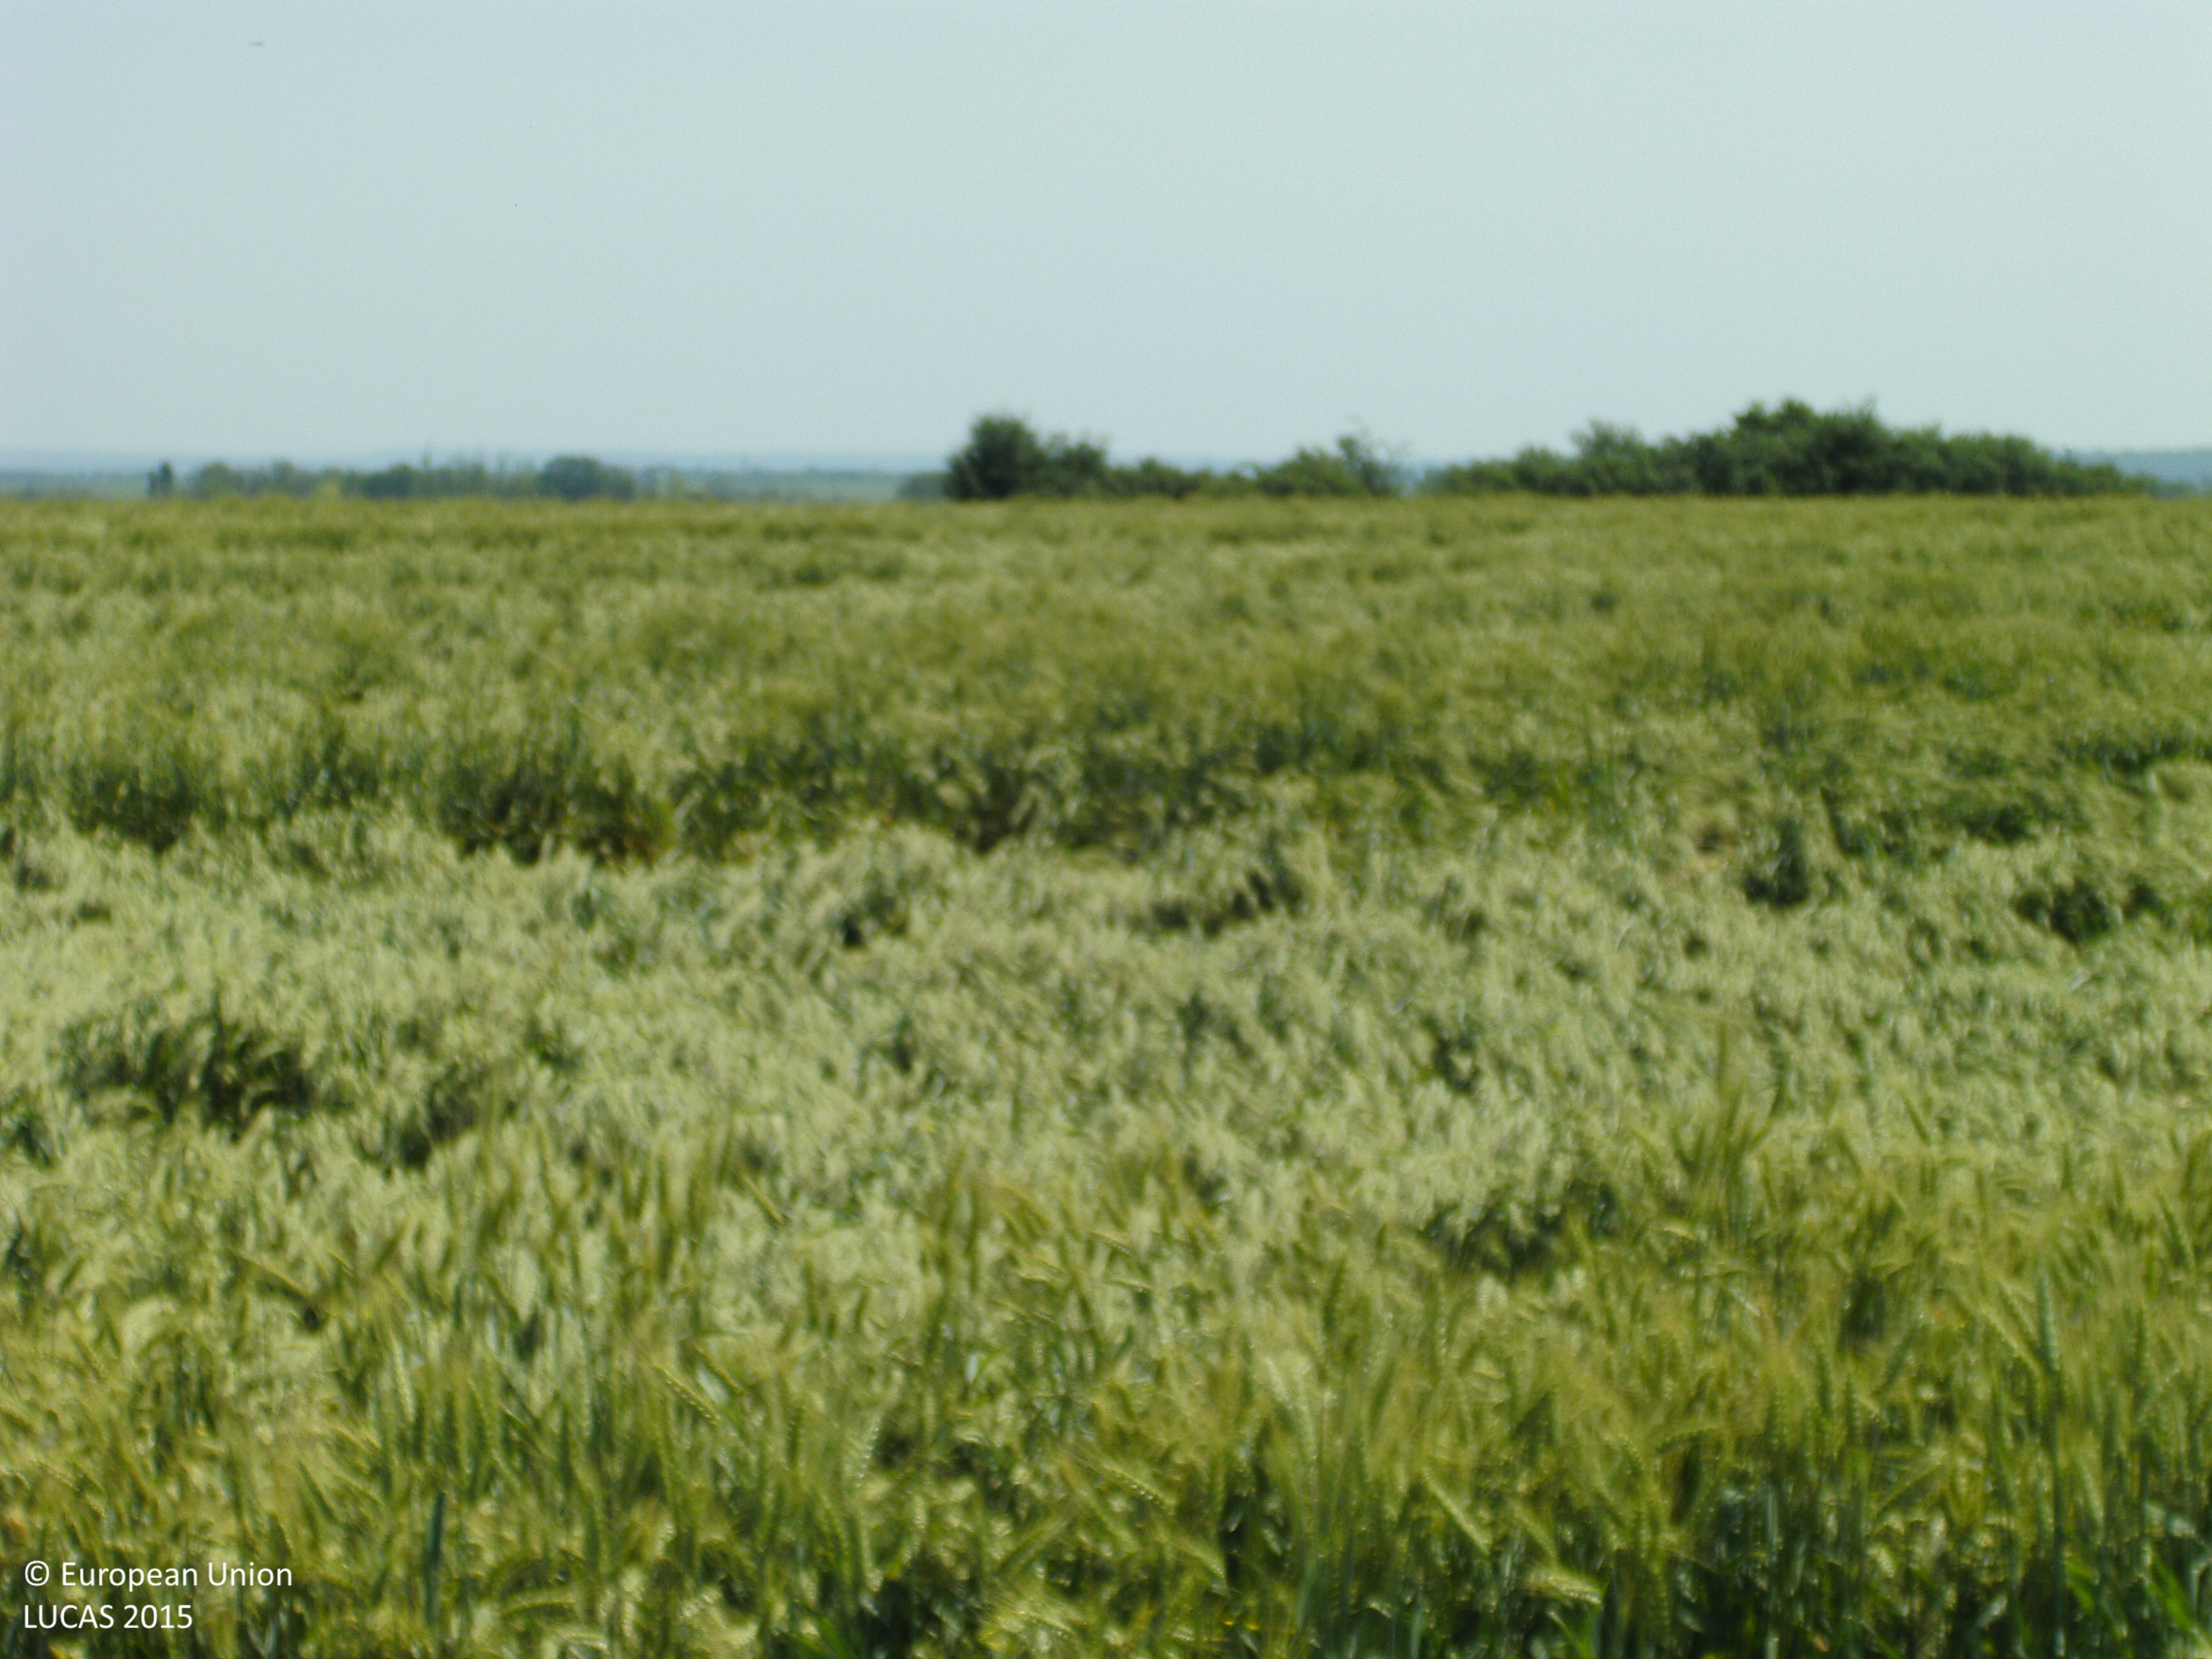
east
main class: Cropland
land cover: Common wheat
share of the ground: > 75 %
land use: Agriculture (excluding fallow land and kitchen gardens)
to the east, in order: Common wheat; Tracks; Common wheat
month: June
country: HU
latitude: 46.3787
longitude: 17.9767
